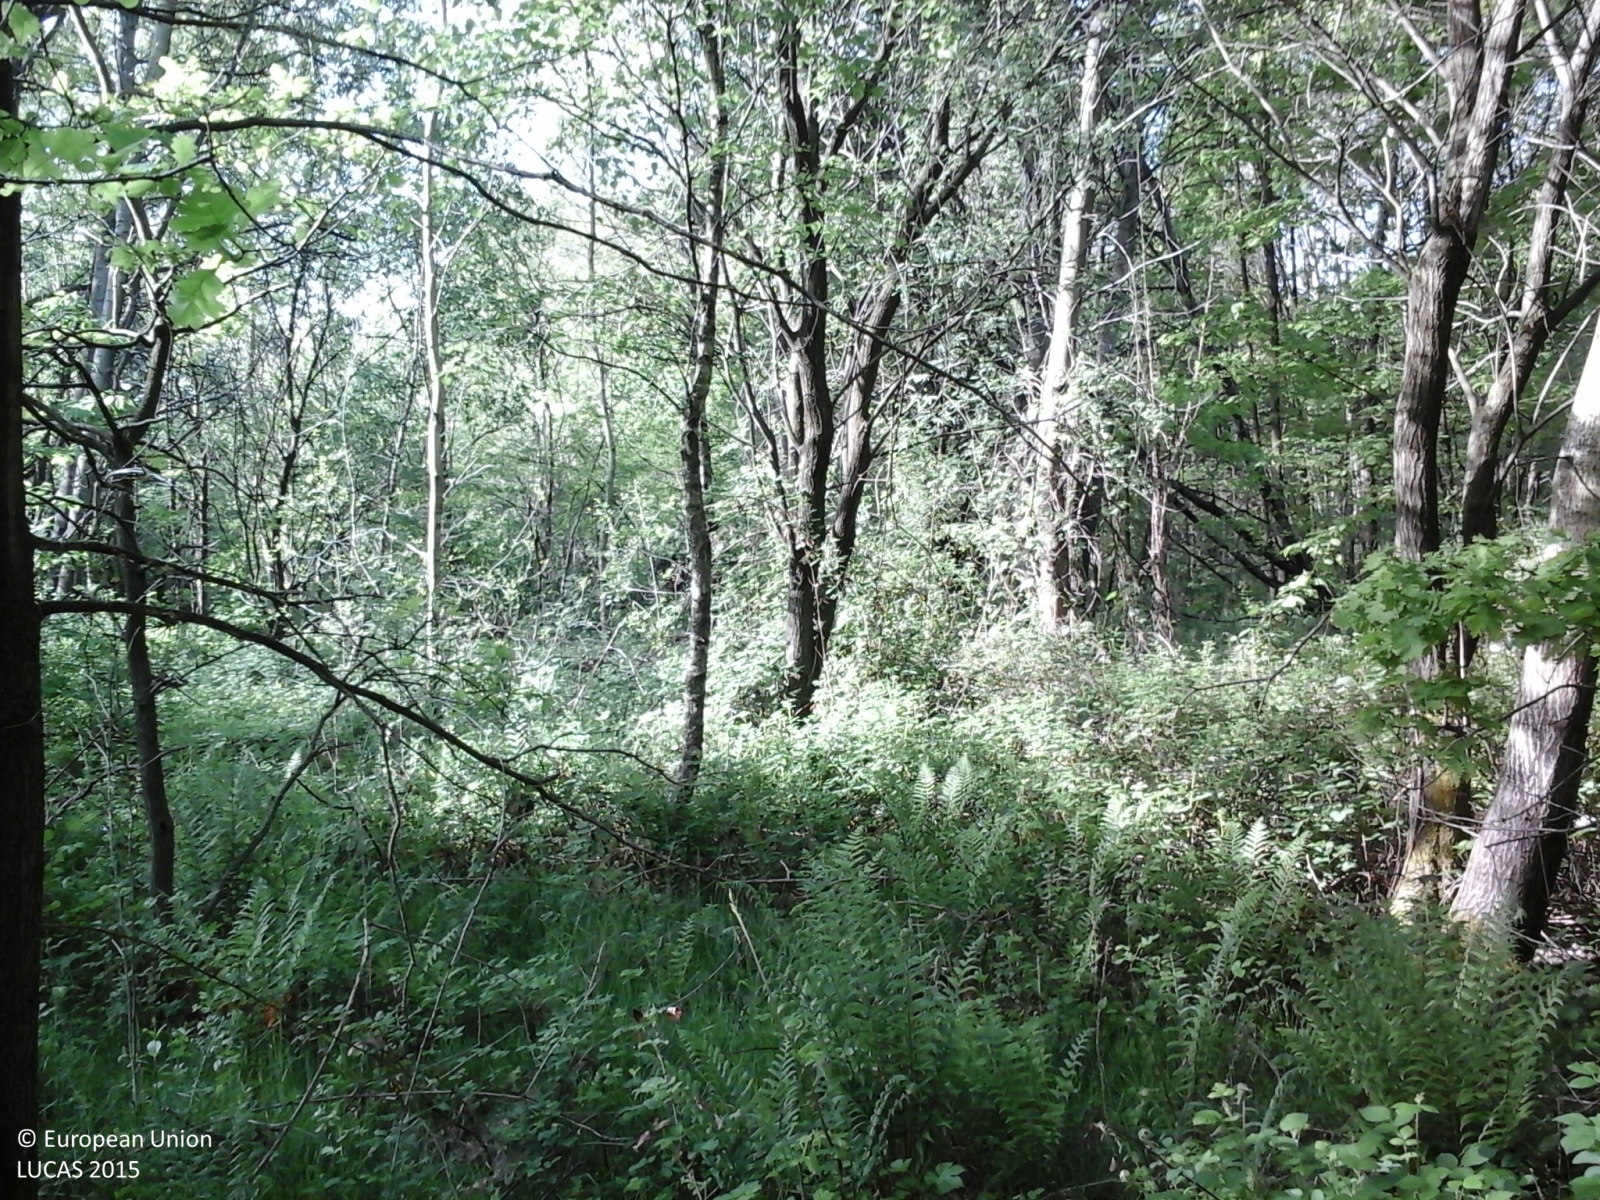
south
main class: Woodland
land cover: Broadleaved woodland
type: mesophytic deciduous forest
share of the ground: > 75 %
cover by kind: broadleaved forest trees 100 %
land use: Forestry
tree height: > 5 m
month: May
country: IT
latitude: 45.6913
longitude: 8.4486
